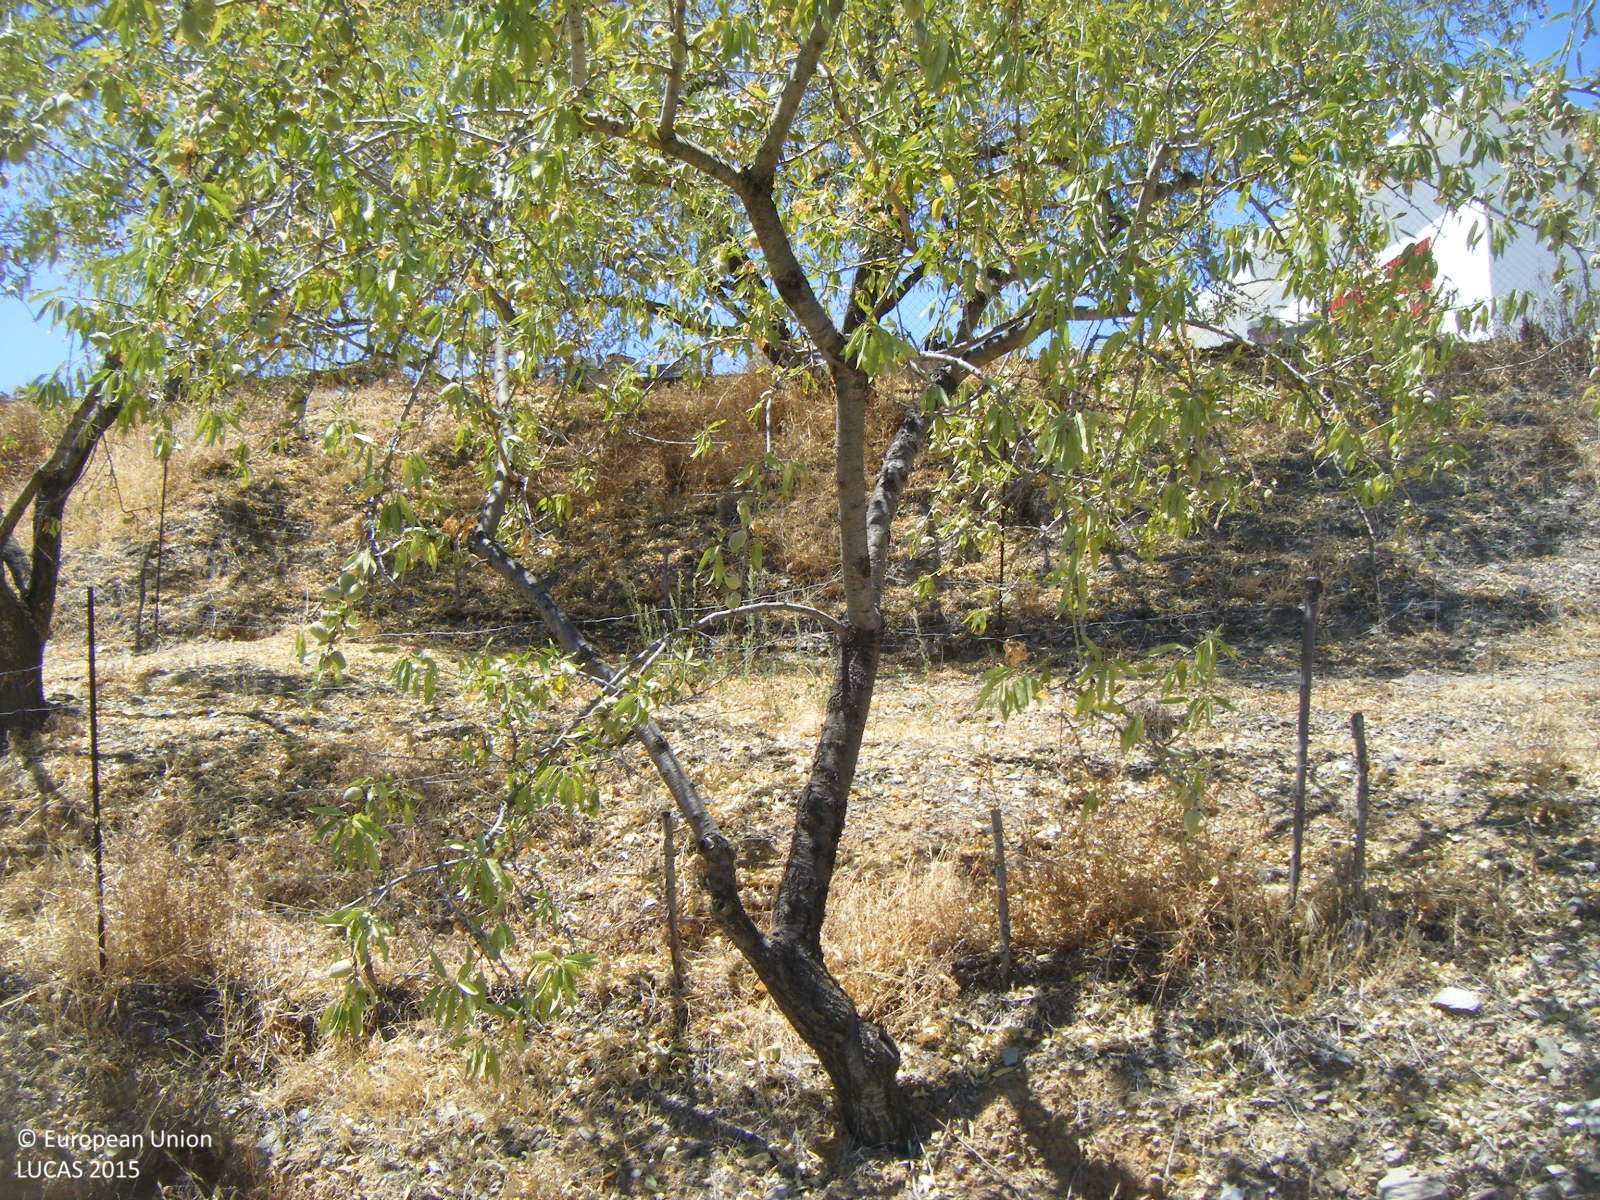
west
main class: Cropland
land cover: Nuts trees
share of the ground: 10 - 25 %
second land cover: Spontaneously vegetated surfaces
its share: > 75 %
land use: Agriculture (excluding fallow land and kitchen gardens)
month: July
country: ES
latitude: 36.8039
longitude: -4.3257
